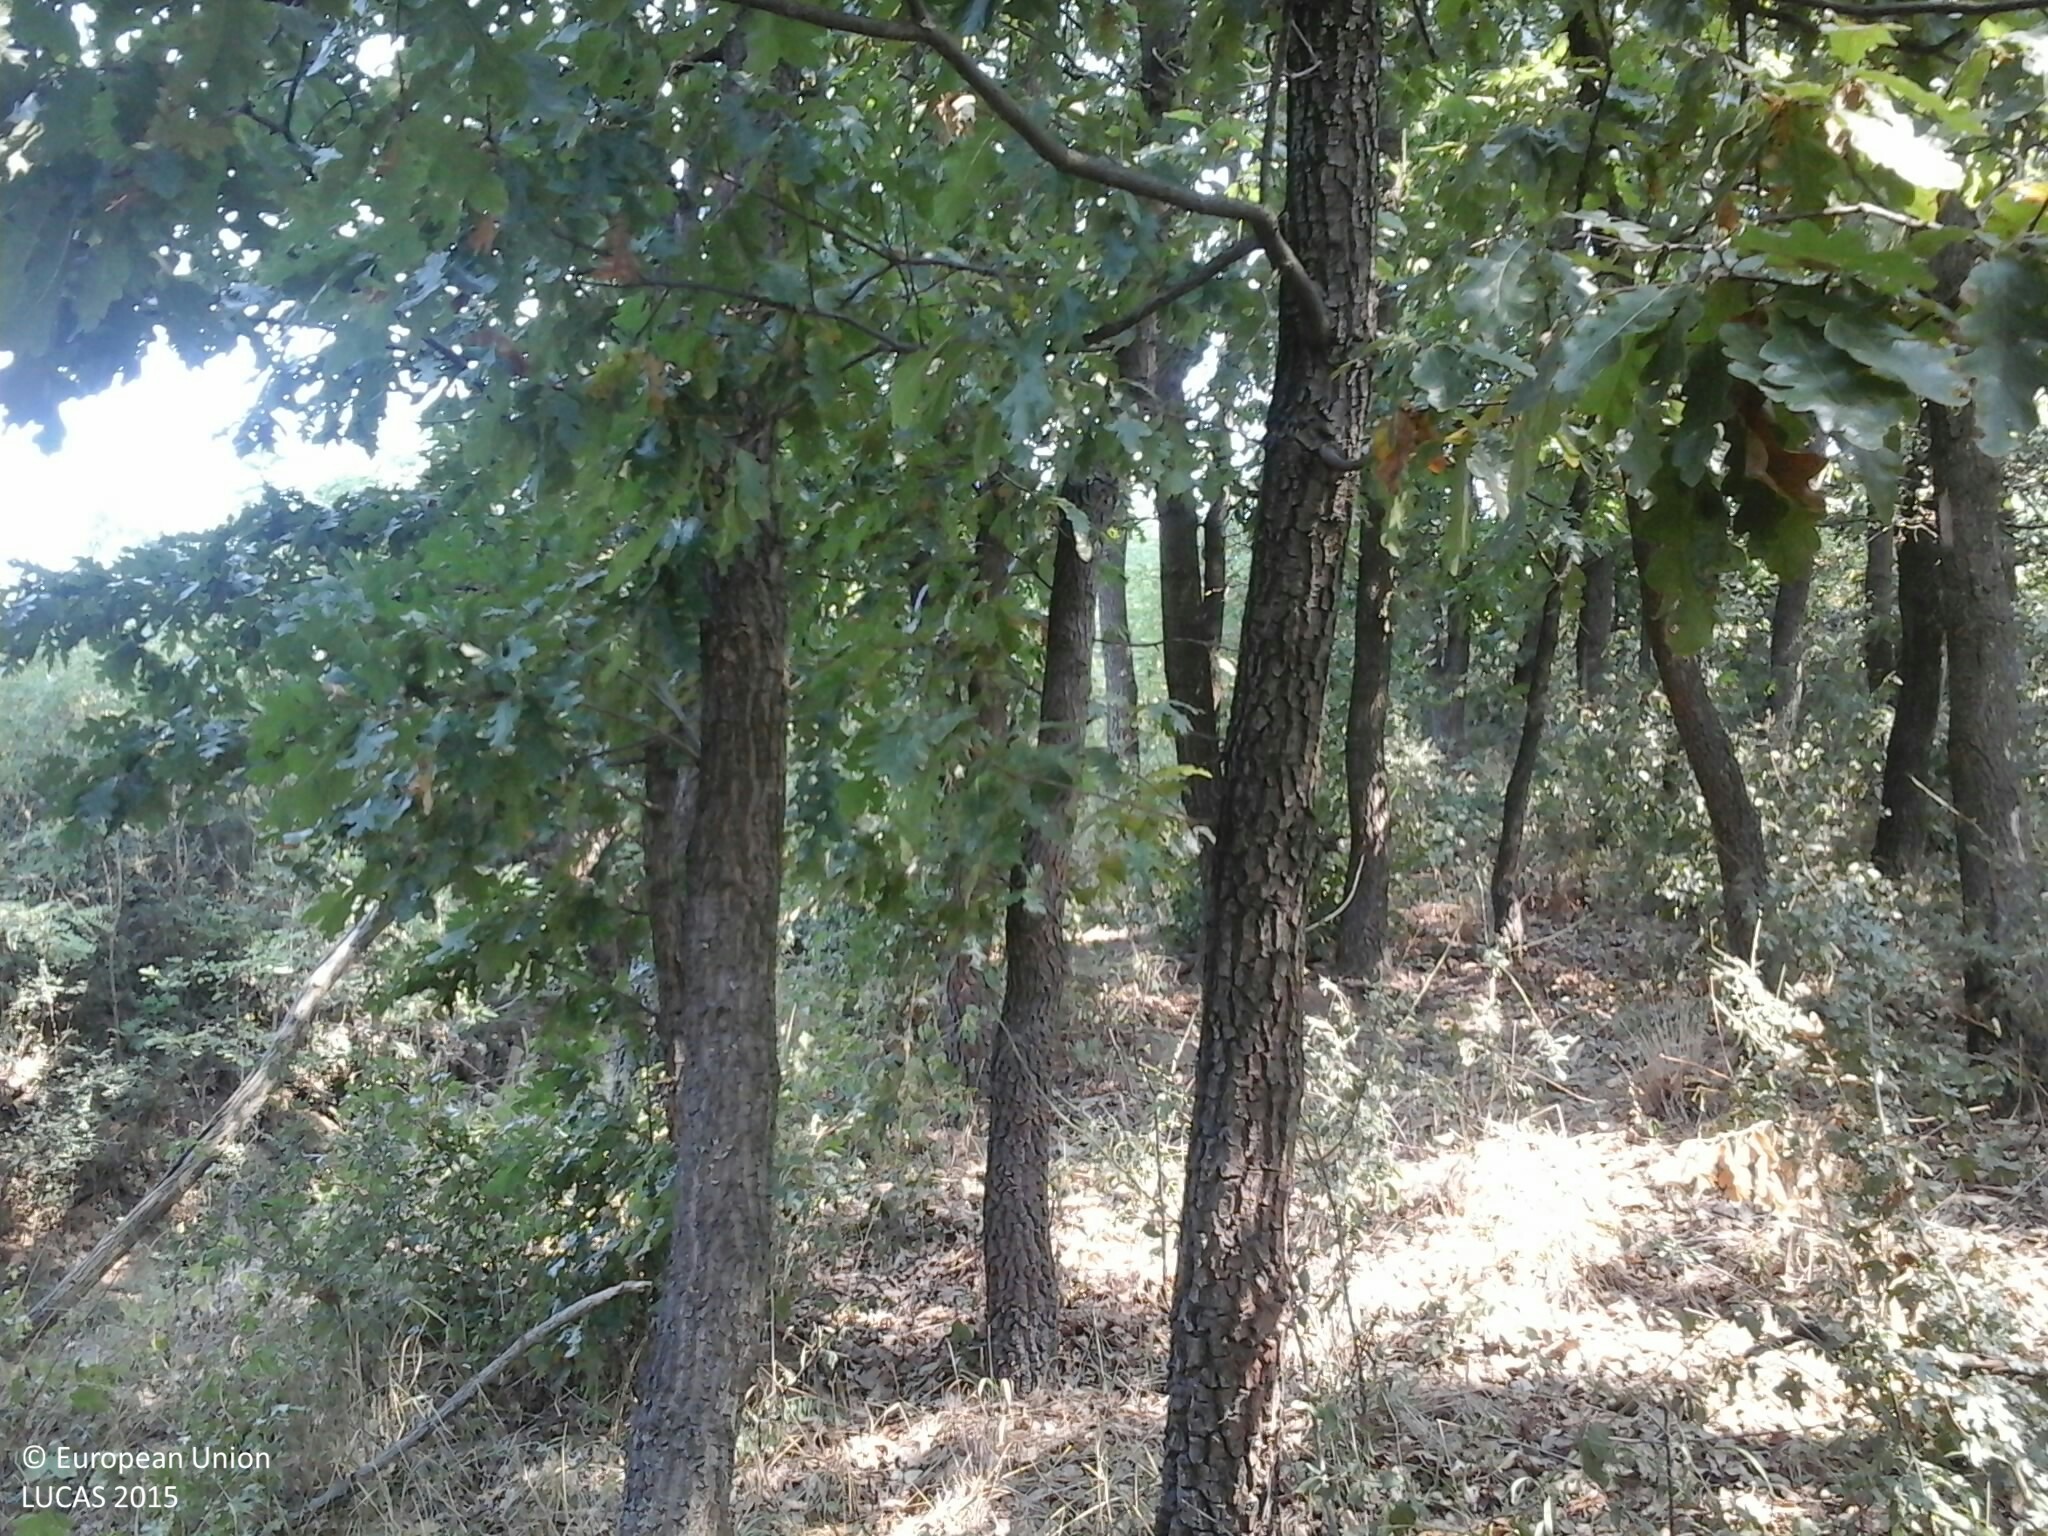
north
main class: Woodland
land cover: Broadleaved woodland
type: thermophilous deciduous forest
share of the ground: > 75 %
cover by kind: broadleaved forest trees 80 %, shrubs 15 %, herbaceous plants 5 %
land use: Forestry
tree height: > 5 m
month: August
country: HU
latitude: 47.9118
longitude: 19.1855
